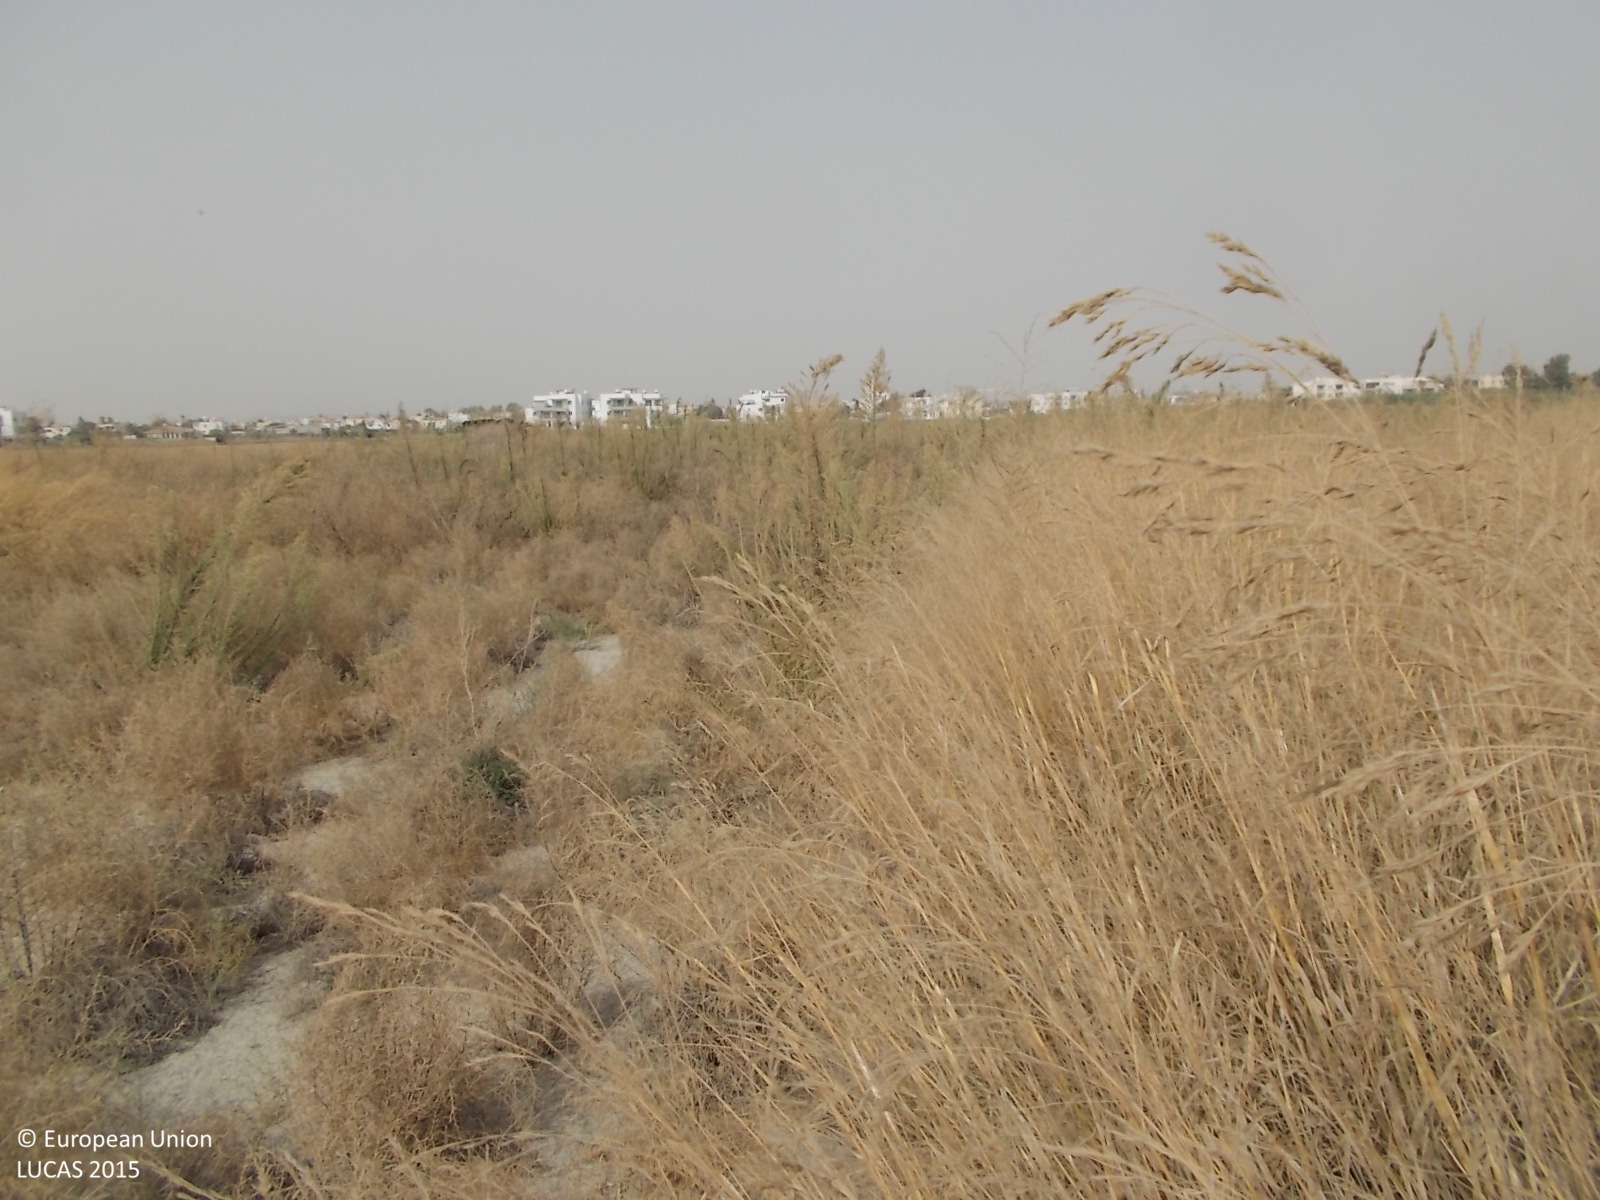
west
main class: Grassland
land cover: Spontaneously vegetated surfaces
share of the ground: > 75 %
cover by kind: herbaceous plants 100 %
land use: Abandoned areas
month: April
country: CY
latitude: 34.9468
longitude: 33.6412
